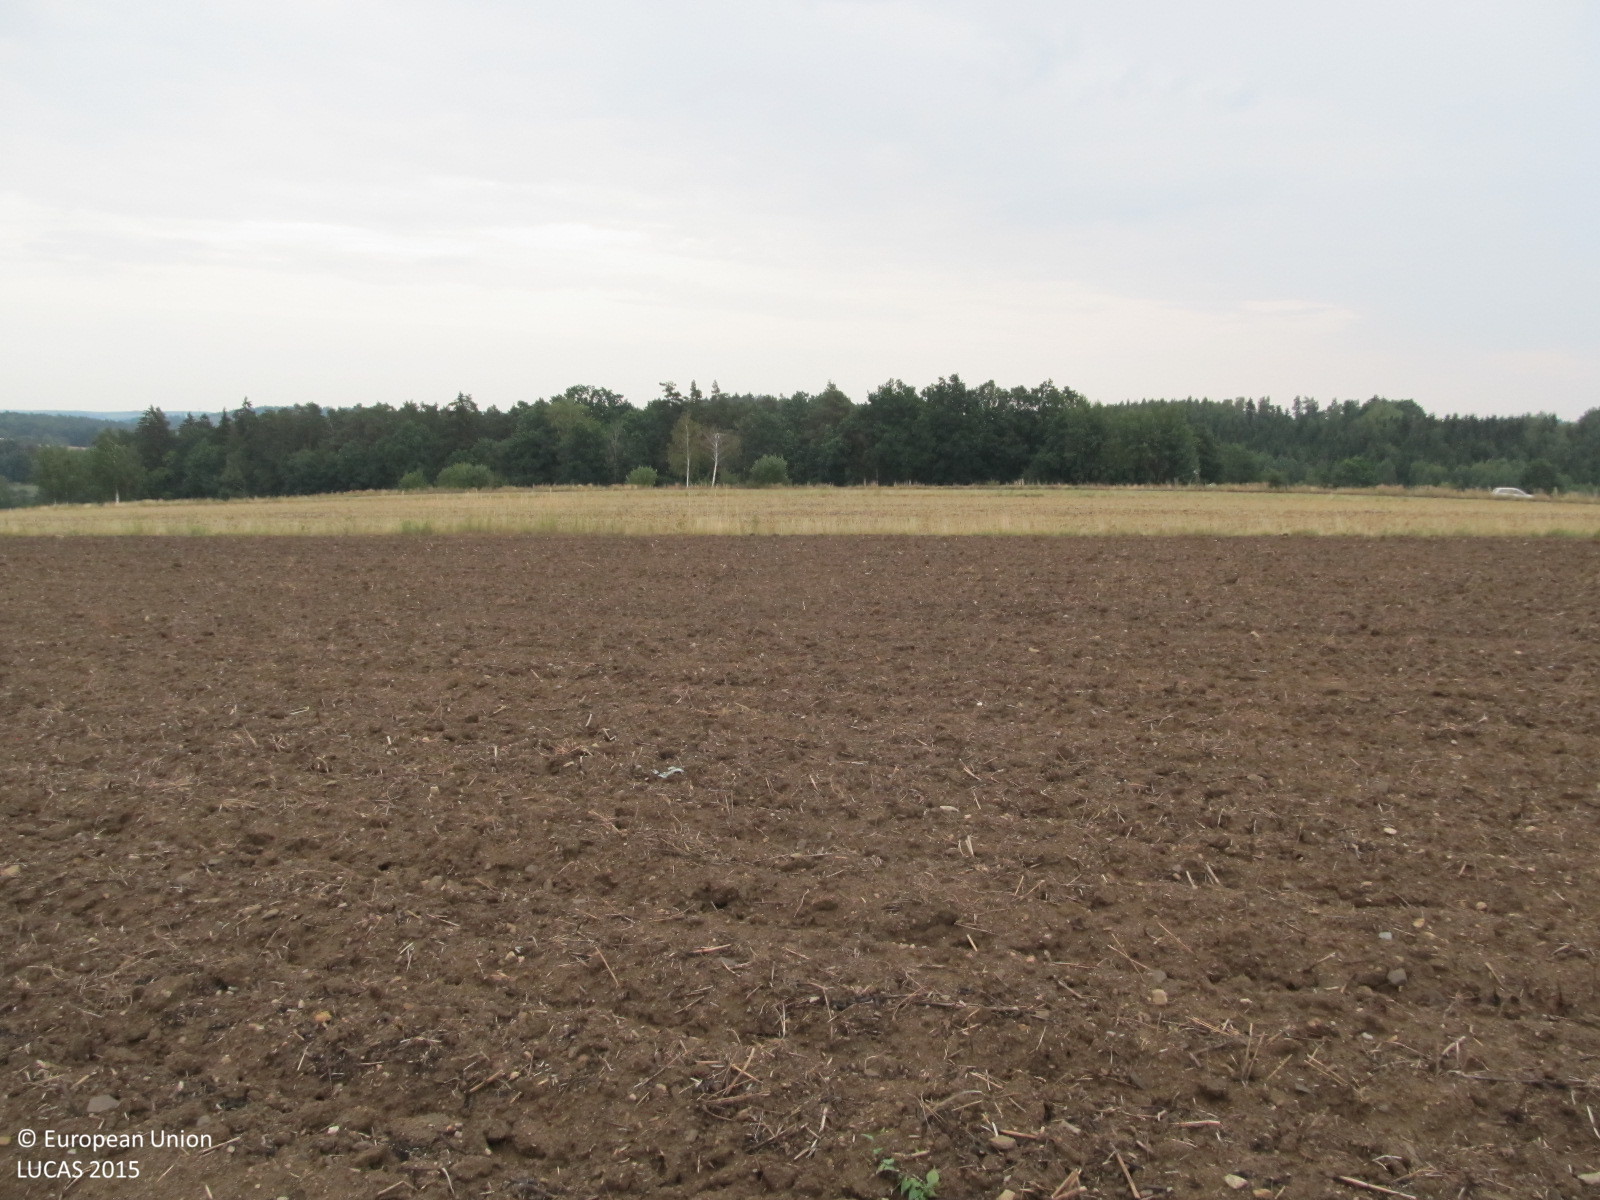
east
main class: Cropland
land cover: Soya
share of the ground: < 10 %
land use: Agriculture (excluding fallow land and kitchen gardens)
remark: Harvested field
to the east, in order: Soya; Common wheat; Barley; Grassland with sparse tree/shrub cover; Ditches and canals; Grass margins; Single bushes/trees; Tracks; Grass margins; Barley; Grassland without tree/shrub cover; Pine dominated mixed woodland
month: August
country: AT
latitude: 48.8413
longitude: 15.5489
